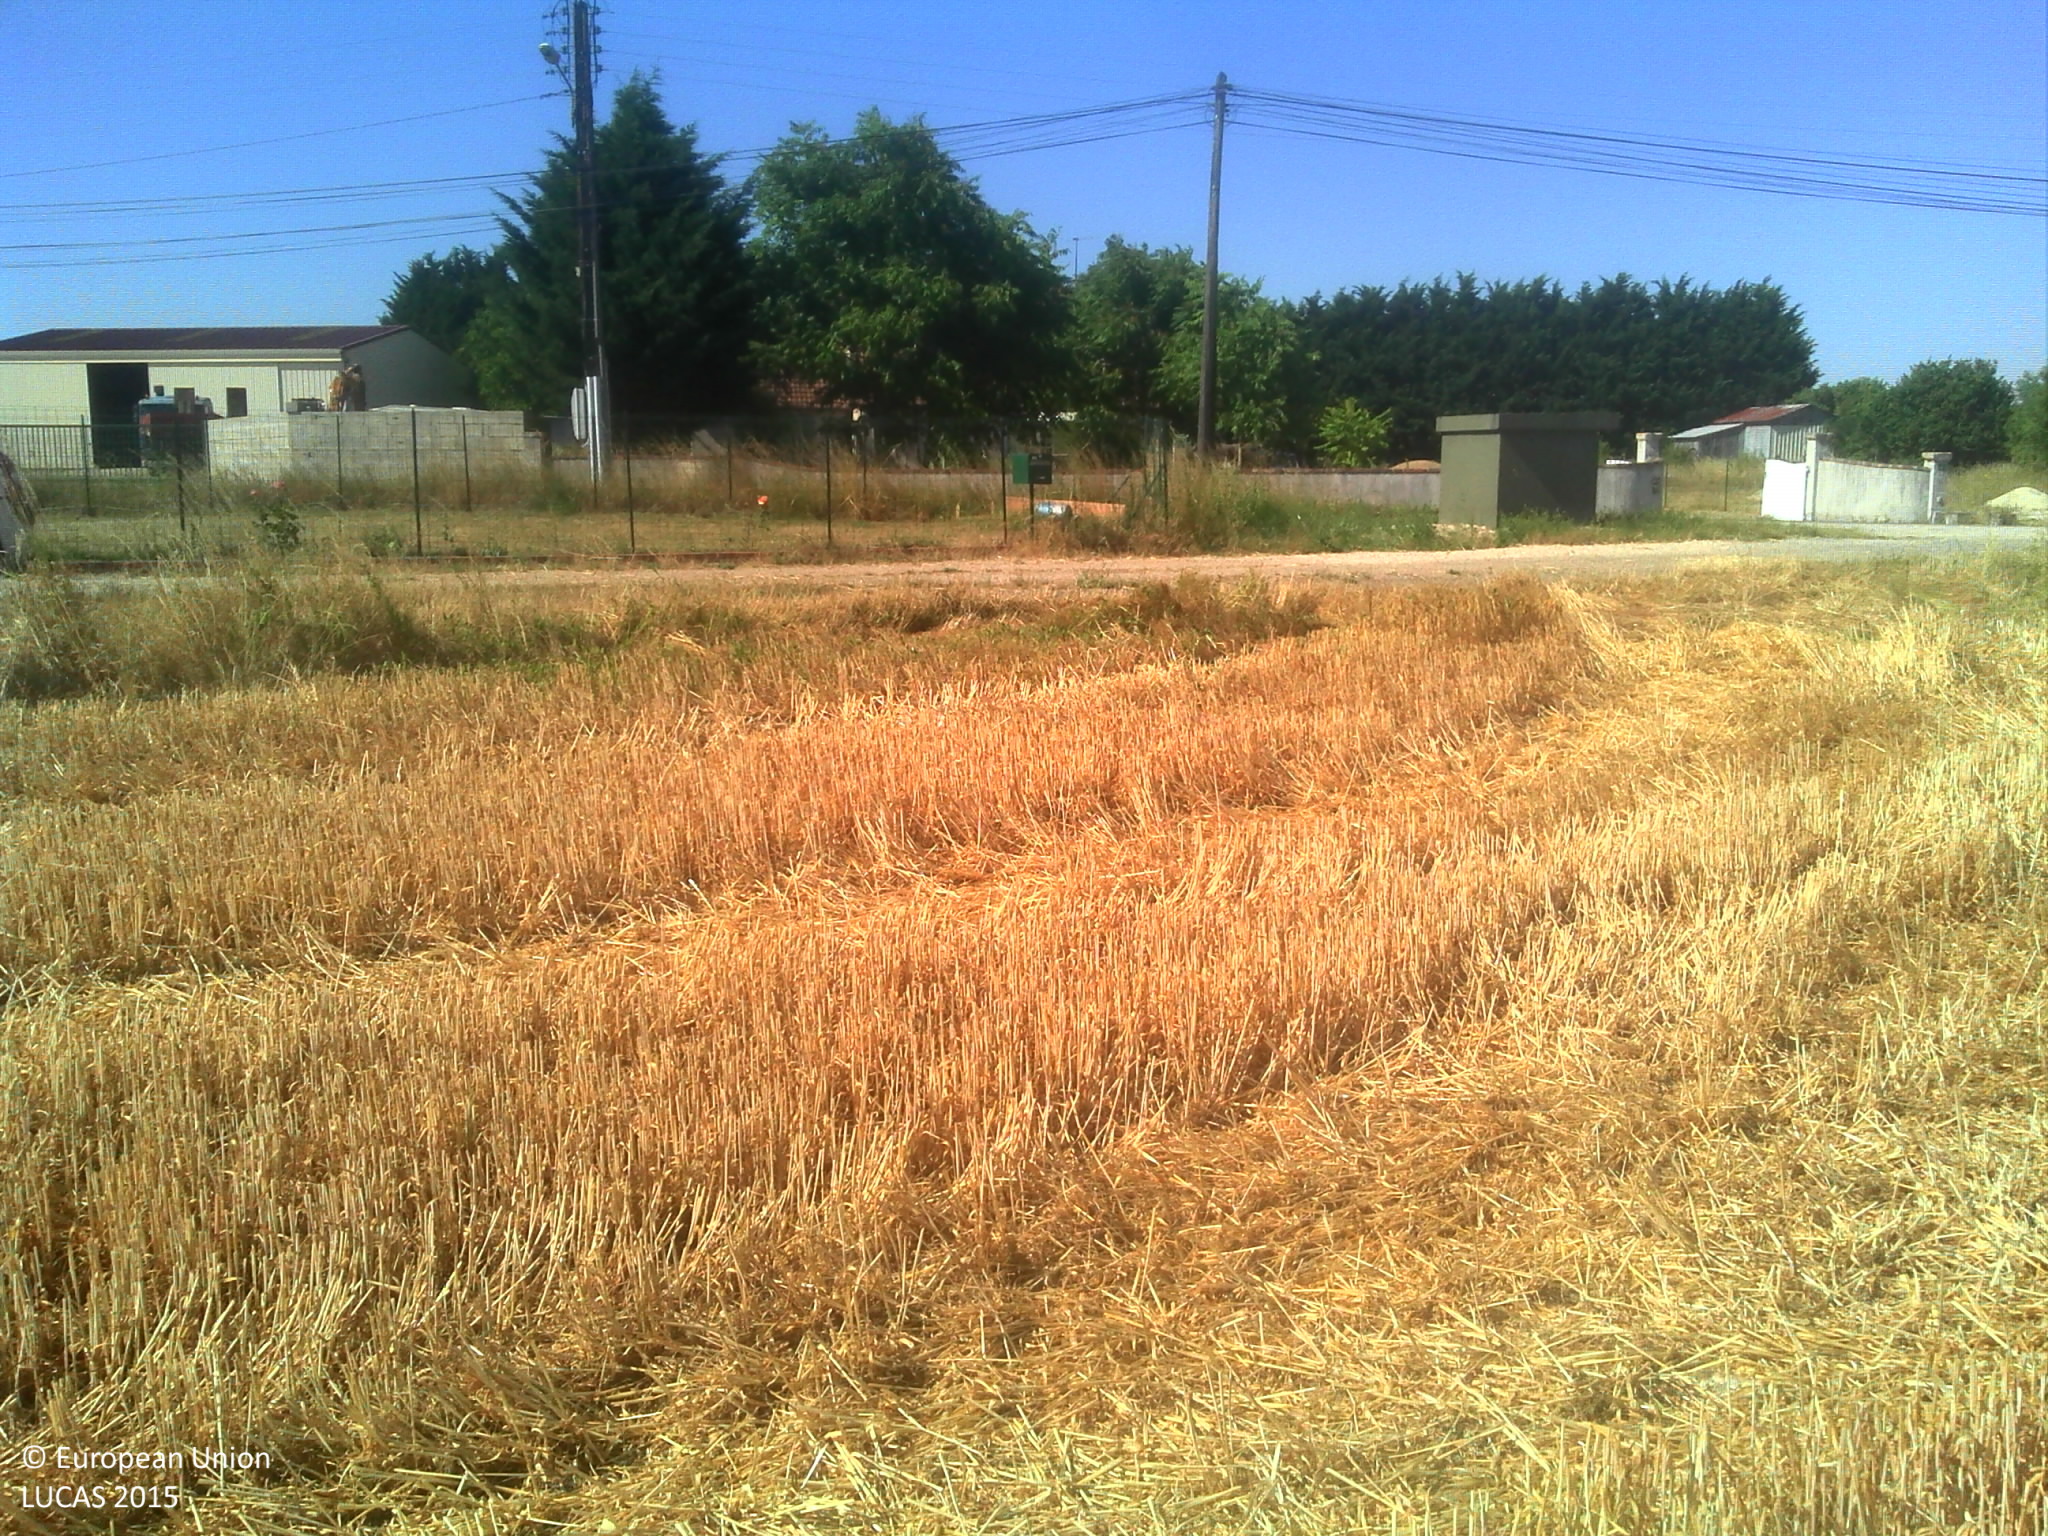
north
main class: Cropland
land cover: Barley
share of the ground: > 75 %
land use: Agriculture (excluding fallow land and kitchen gardens)
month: June
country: FR
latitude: 47.3300
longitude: 1.4513
